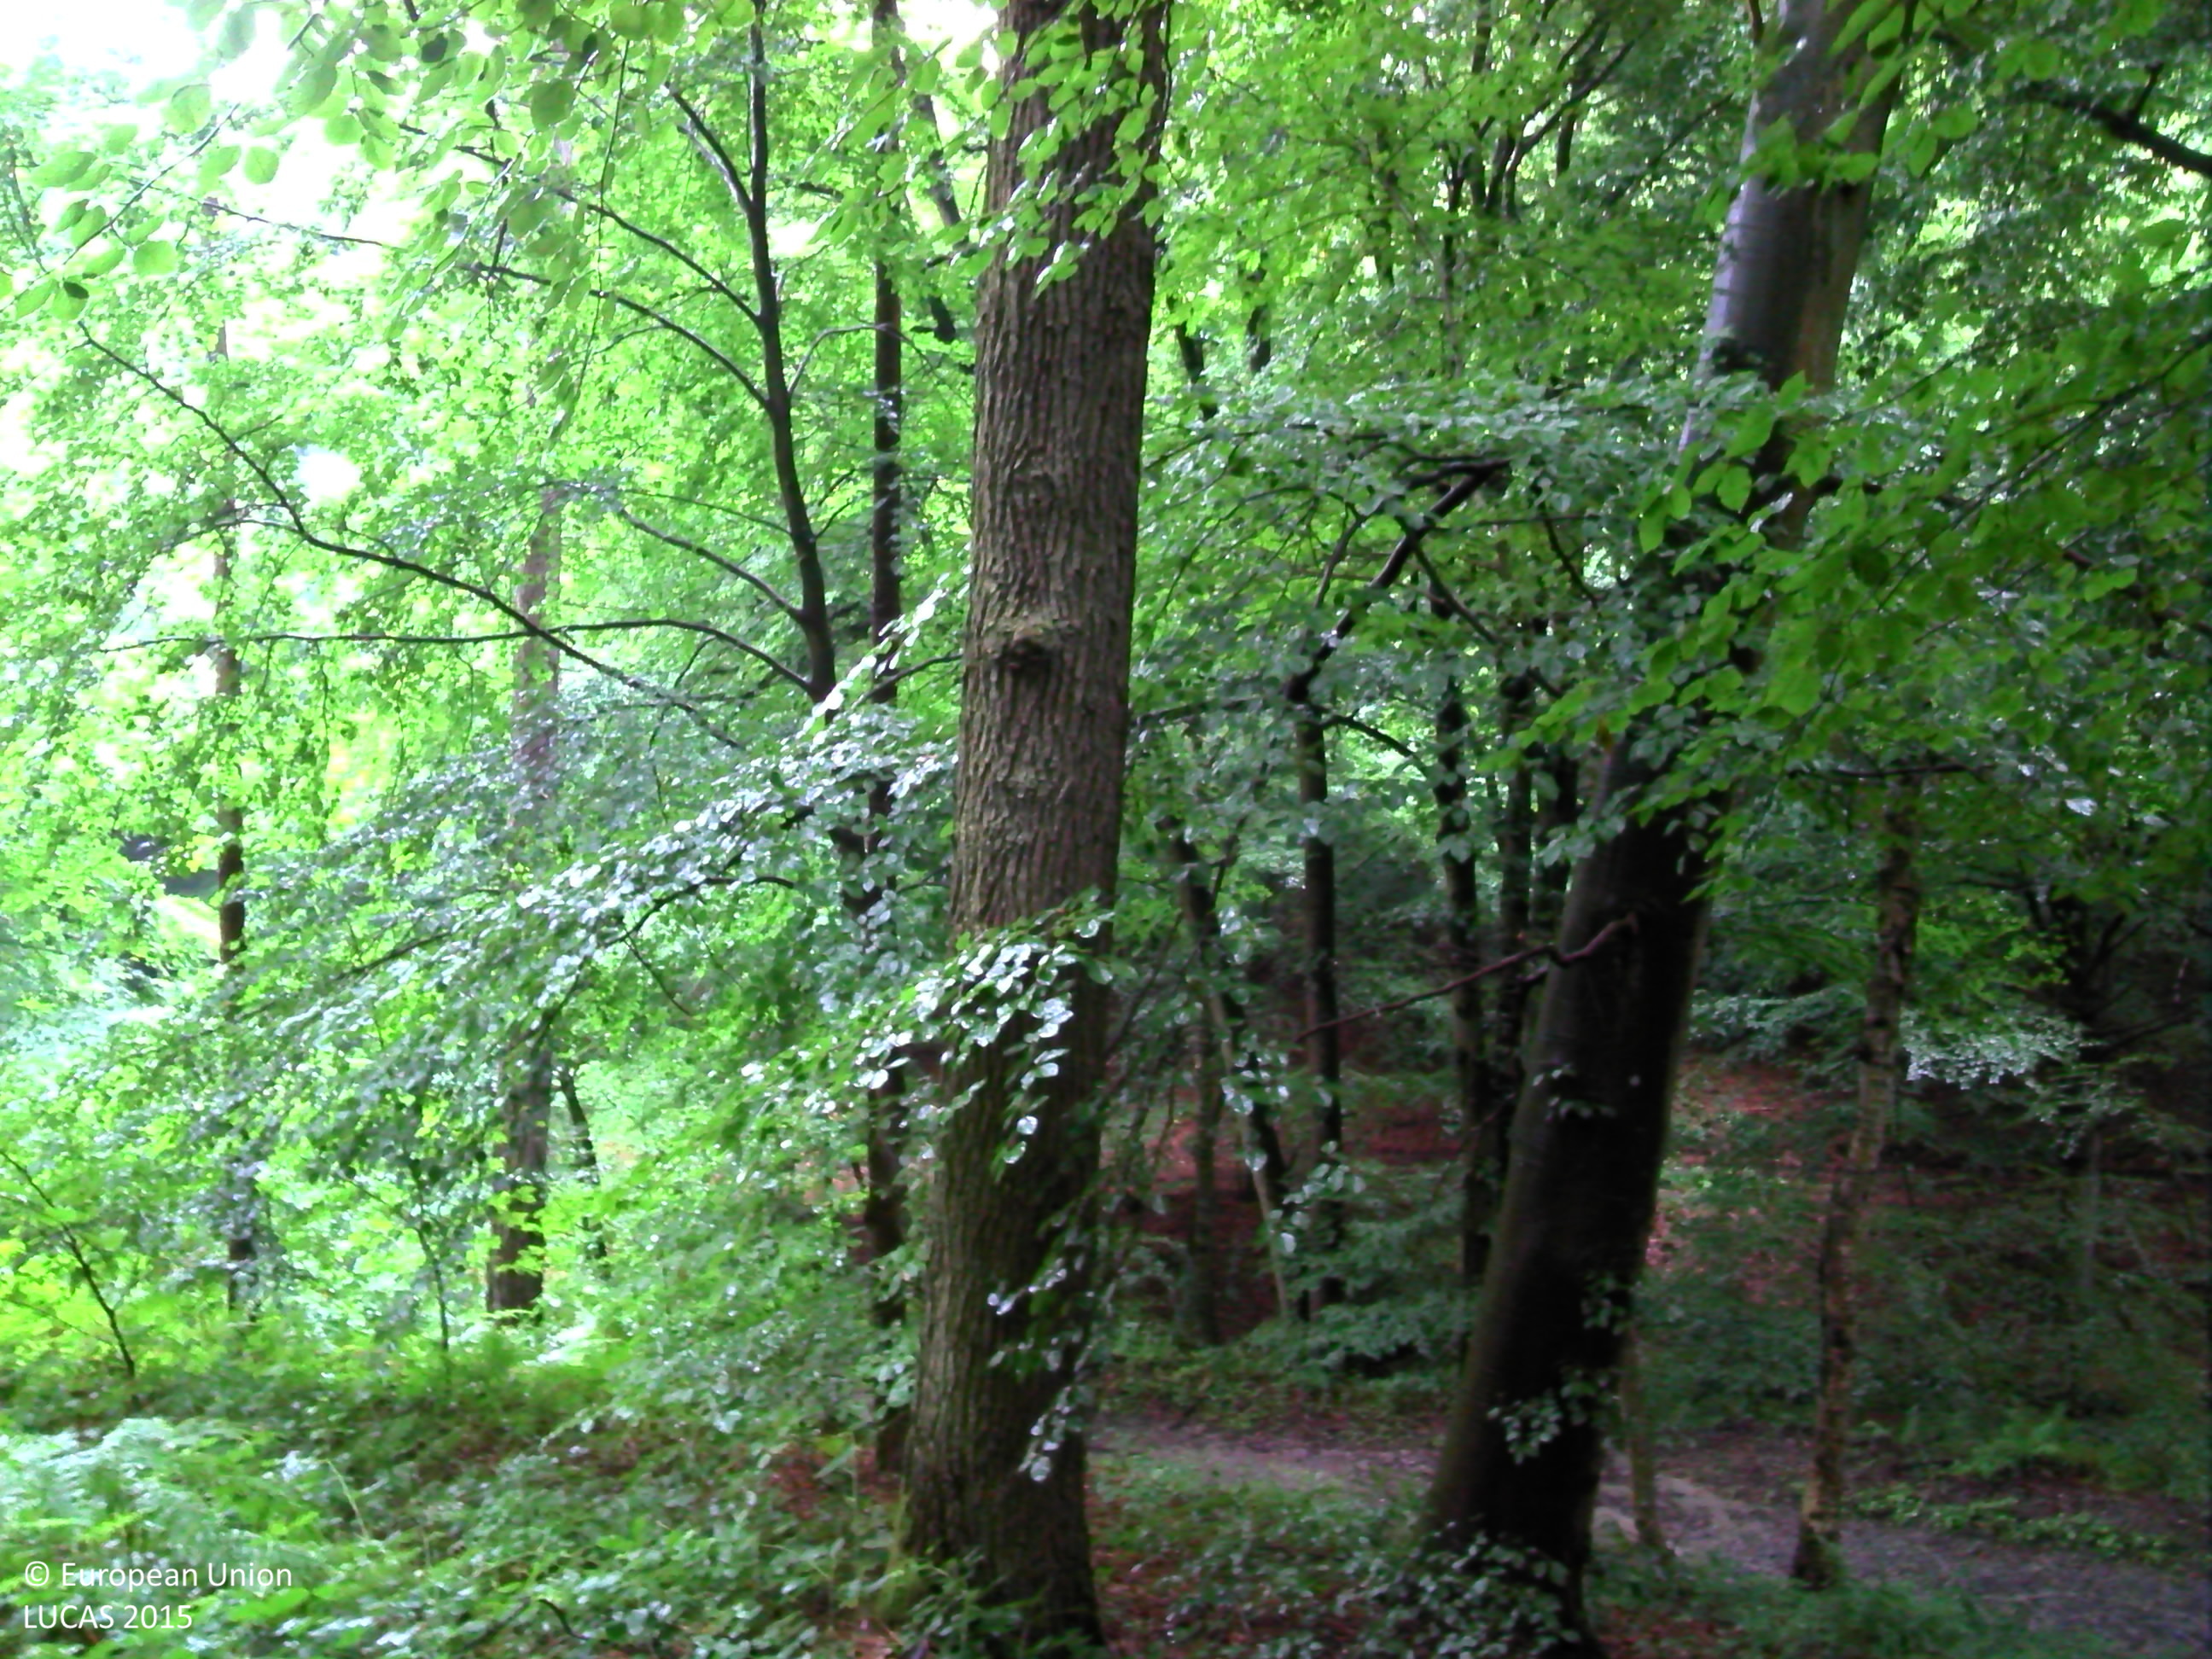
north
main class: Woodland
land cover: Broadleaved woodland
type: acidophilous oak and oak-birch forest
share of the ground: > 75 %
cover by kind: broadleaved forest trees 95 %, herbaceous plants 5 %
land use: Forestry
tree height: > 5 m
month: July
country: BE
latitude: 50.5197
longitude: 5.3011
